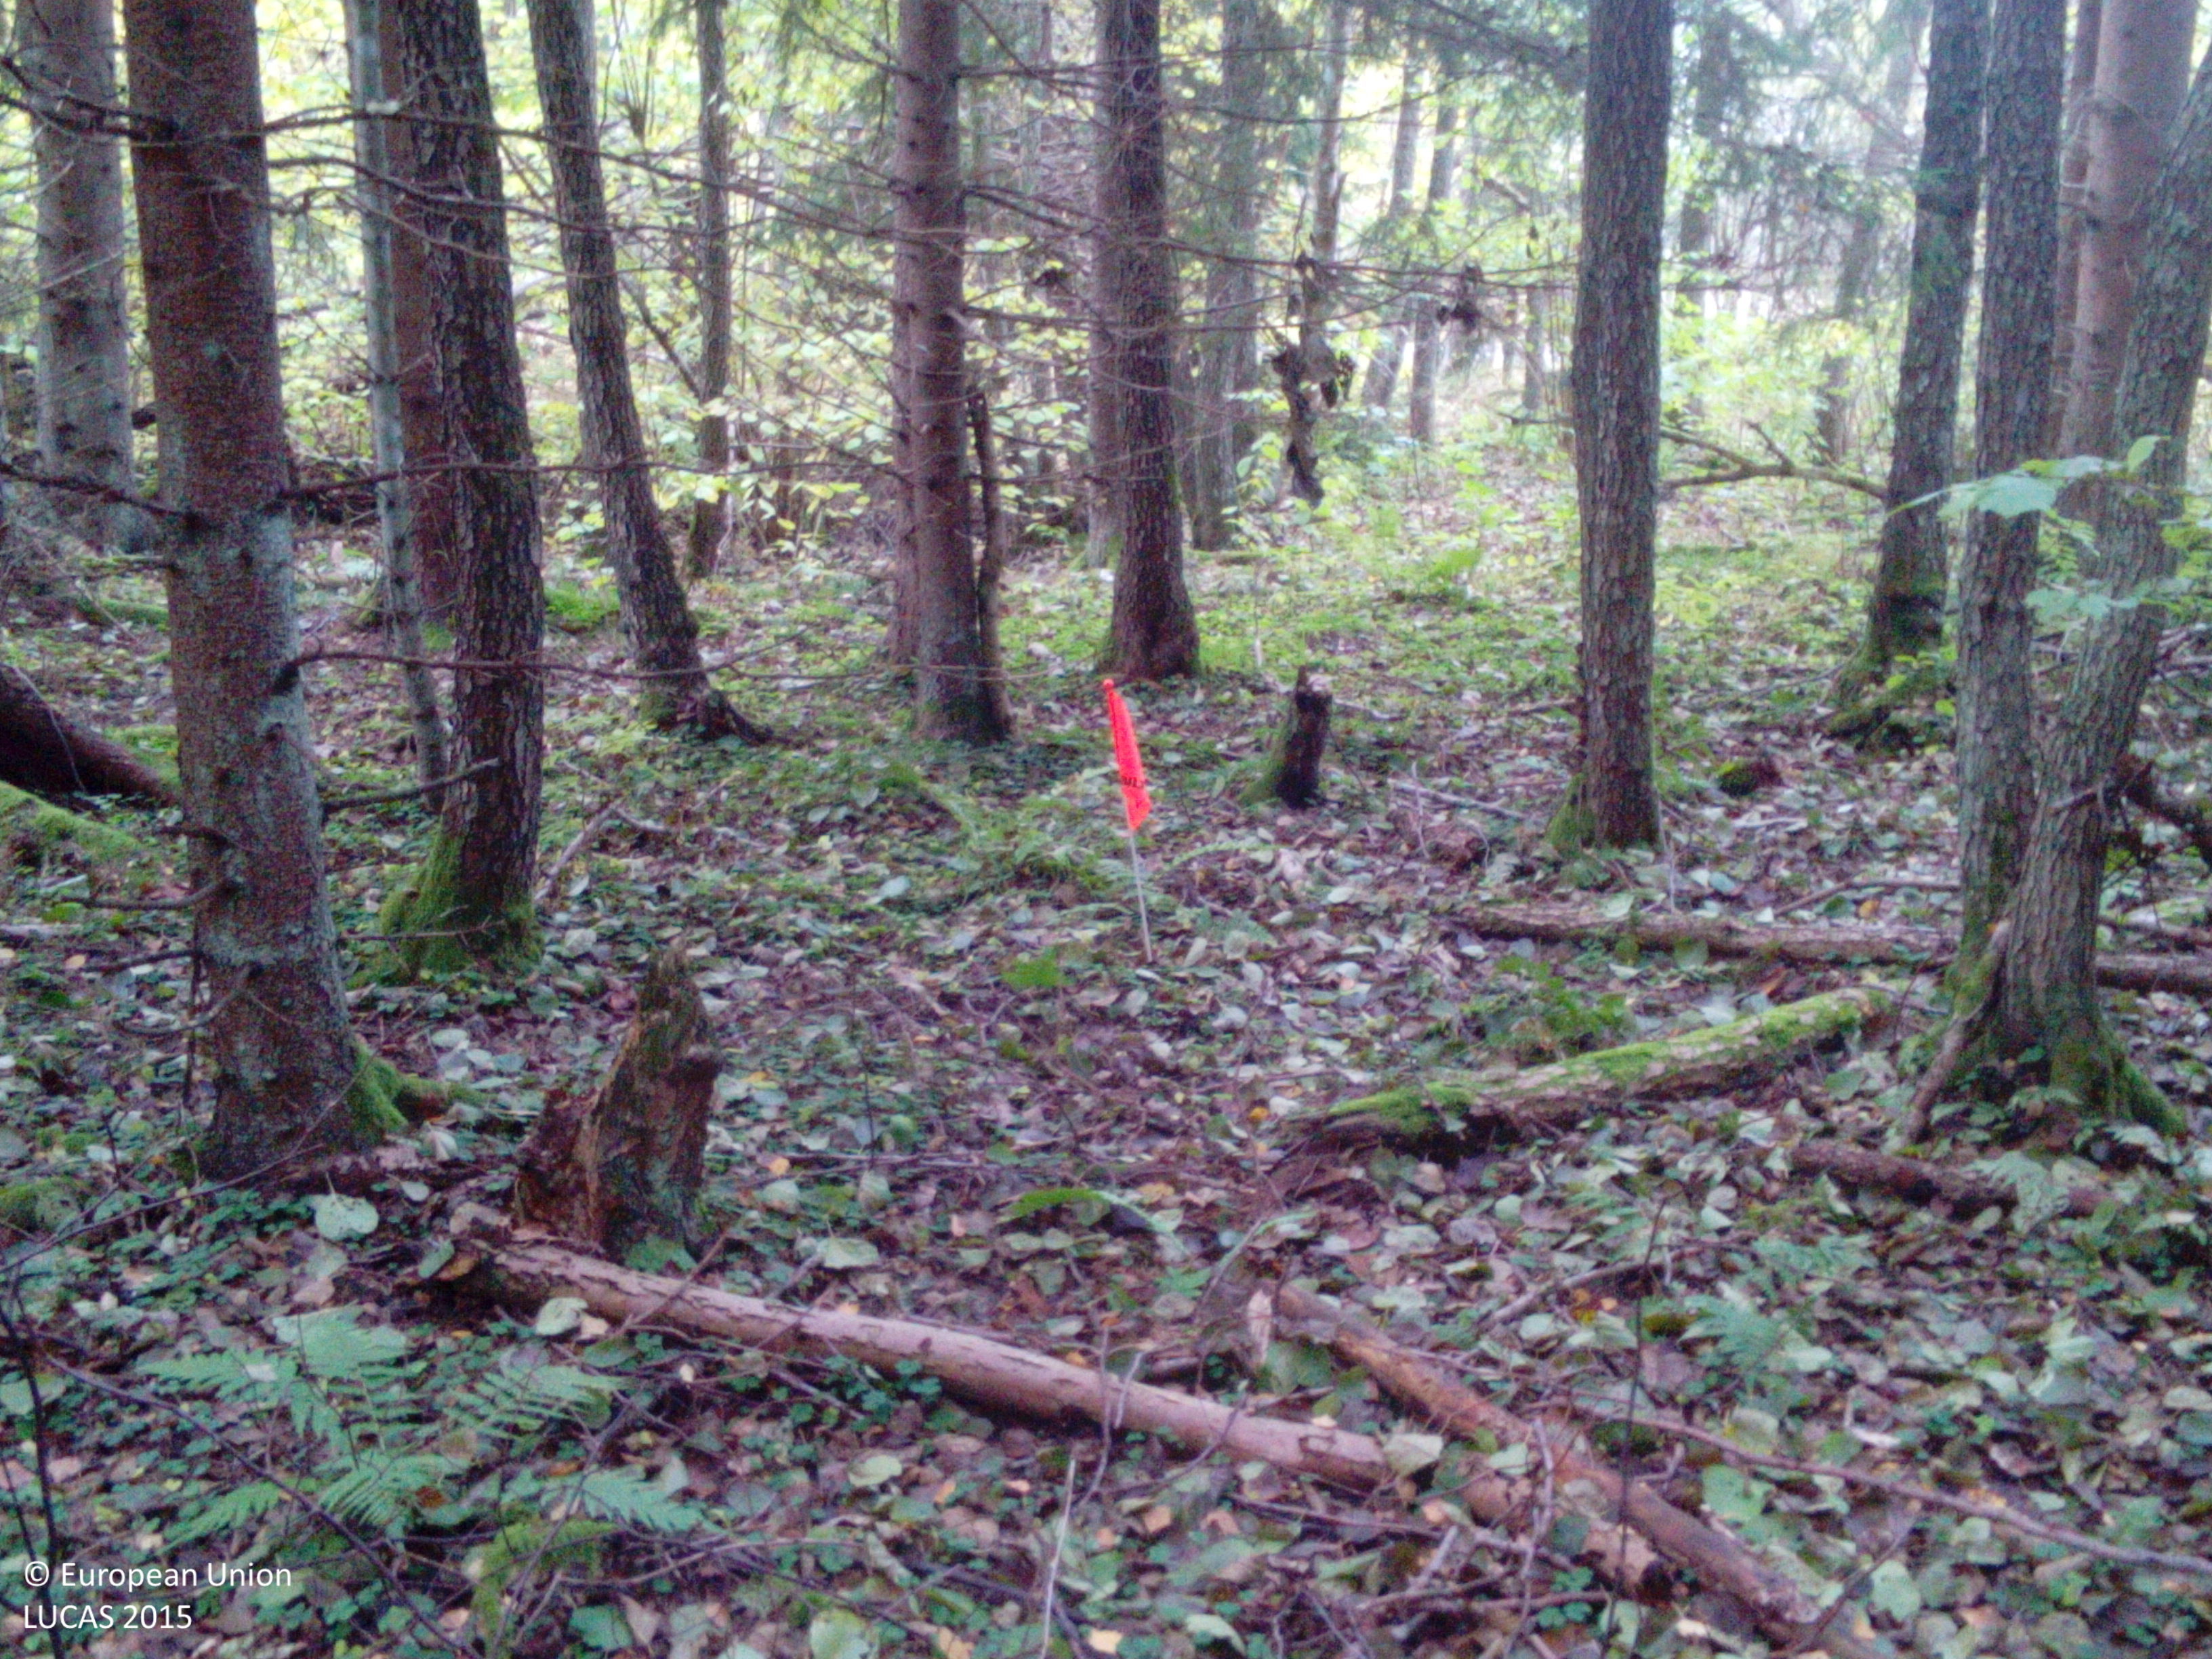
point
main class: Woodland
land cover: Spruce dominated mixed woodland
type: boreal forest
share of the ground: > 75 %
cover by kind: coniferous forest trees 55 %, broadleaved forest trees 35 %, herbaceous plants 10 %
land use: Forestry
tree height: > 5 m
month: October
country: SE
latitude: 59.2784
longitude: 16.3635
